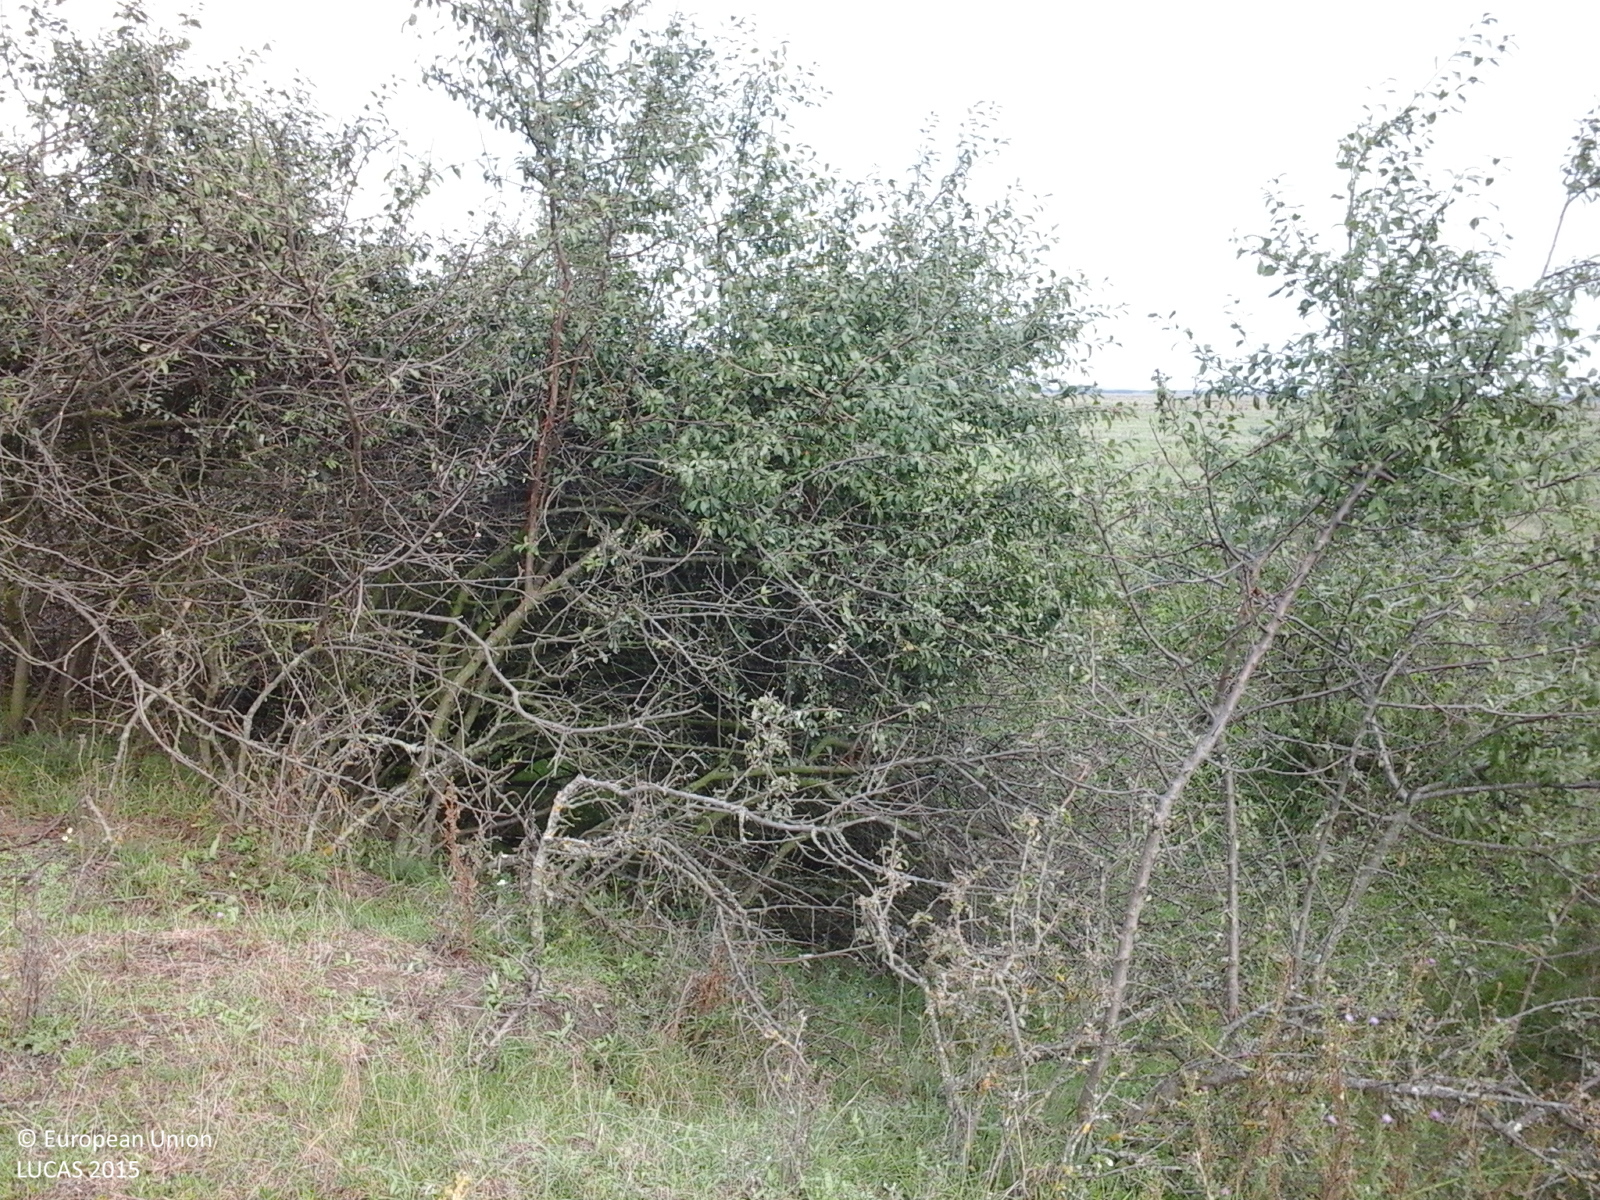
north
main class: Grassland
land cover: Grassland without tree/shrub cover
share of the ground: > 75 %
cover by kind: herbaceous plants 100 %
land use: Agriculture (excluding fallow land and kitchen gardens)
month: September
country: RO
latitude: 46.6756
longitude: 21.8210
